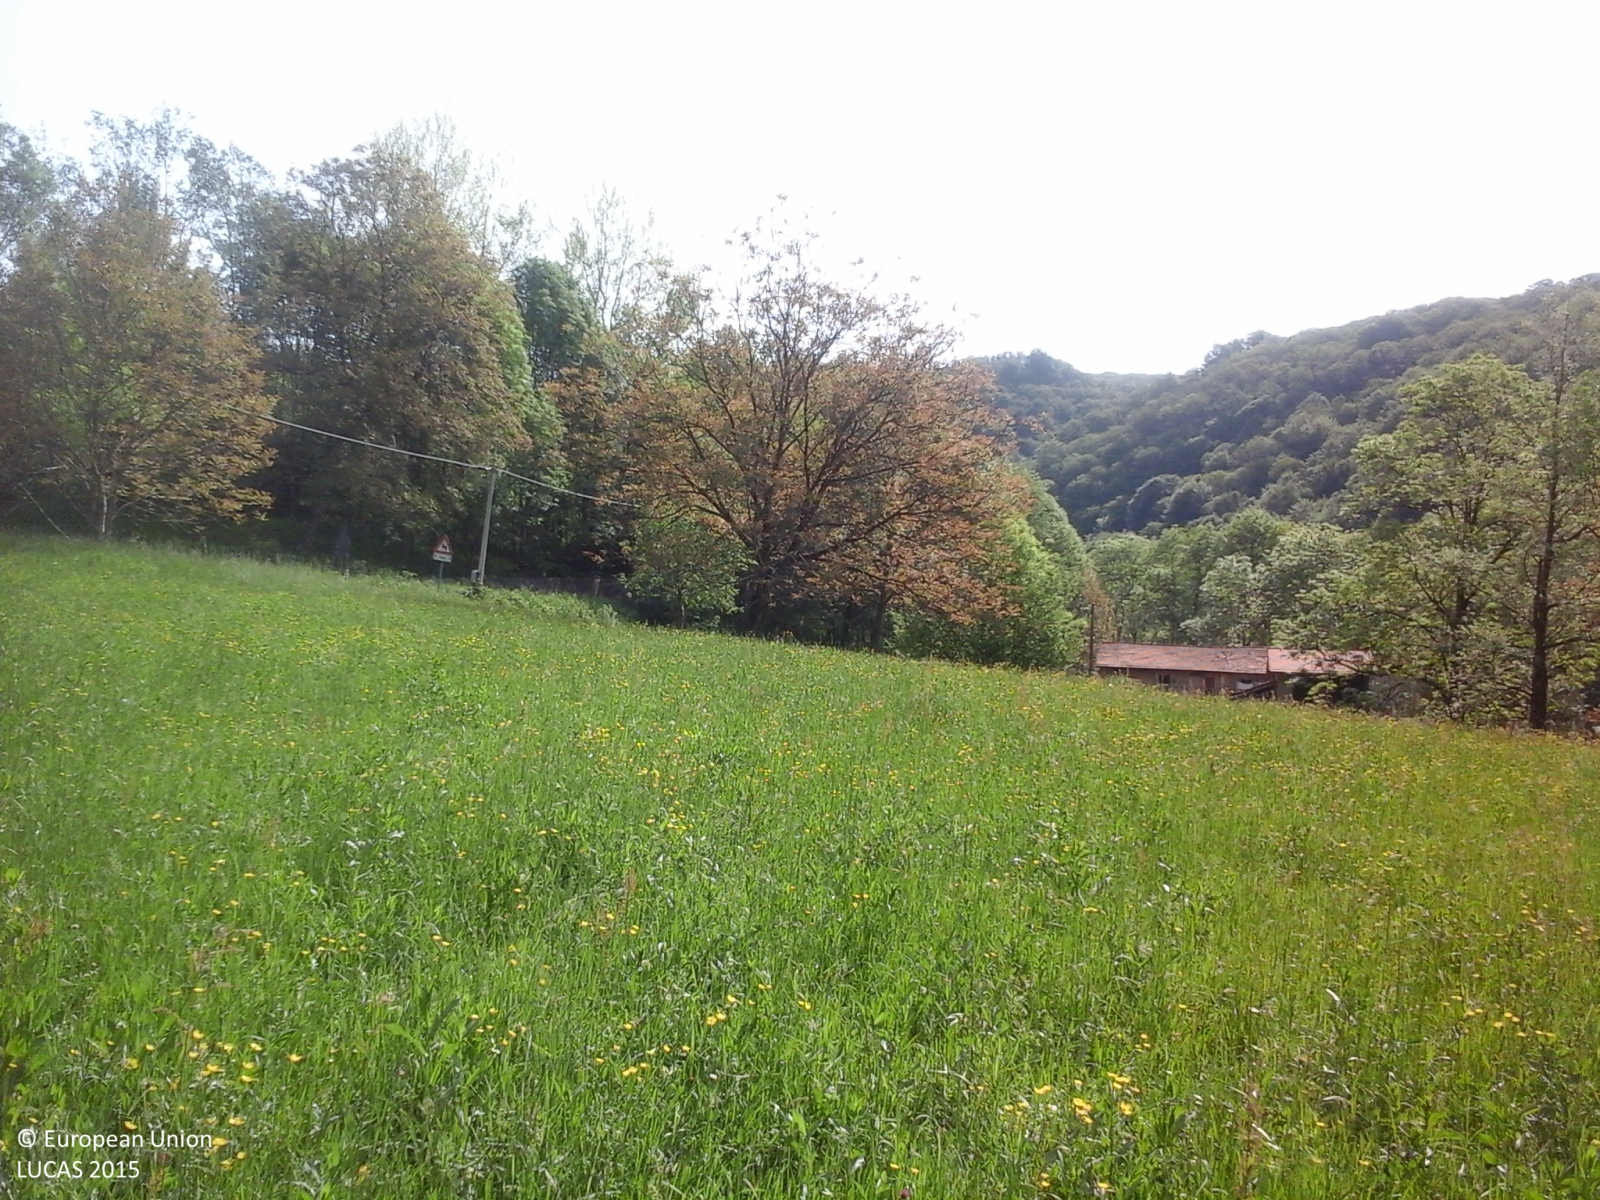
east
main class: Grassland
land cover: Grassland with sparse tree/shrub cover
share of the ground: > 75 %
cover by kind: herbaceous plants 95 %, broadleaved forest trees 5 %
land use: Agriculture (excluding fallow land and kitchen gardens)
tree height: > 5 m
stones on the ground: < 10 %
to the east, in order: Grassland with sparse tree/shrub cover; Artificial constructions in urban areas; Grassland without tree/shrub cover; Electric lines; Grassland with sparse tree/shrub cover; Broadleaved woodland; Rivers and streams; Broadleaved woodland
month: May
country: IT
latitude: 45.8177
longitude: 8.4707
